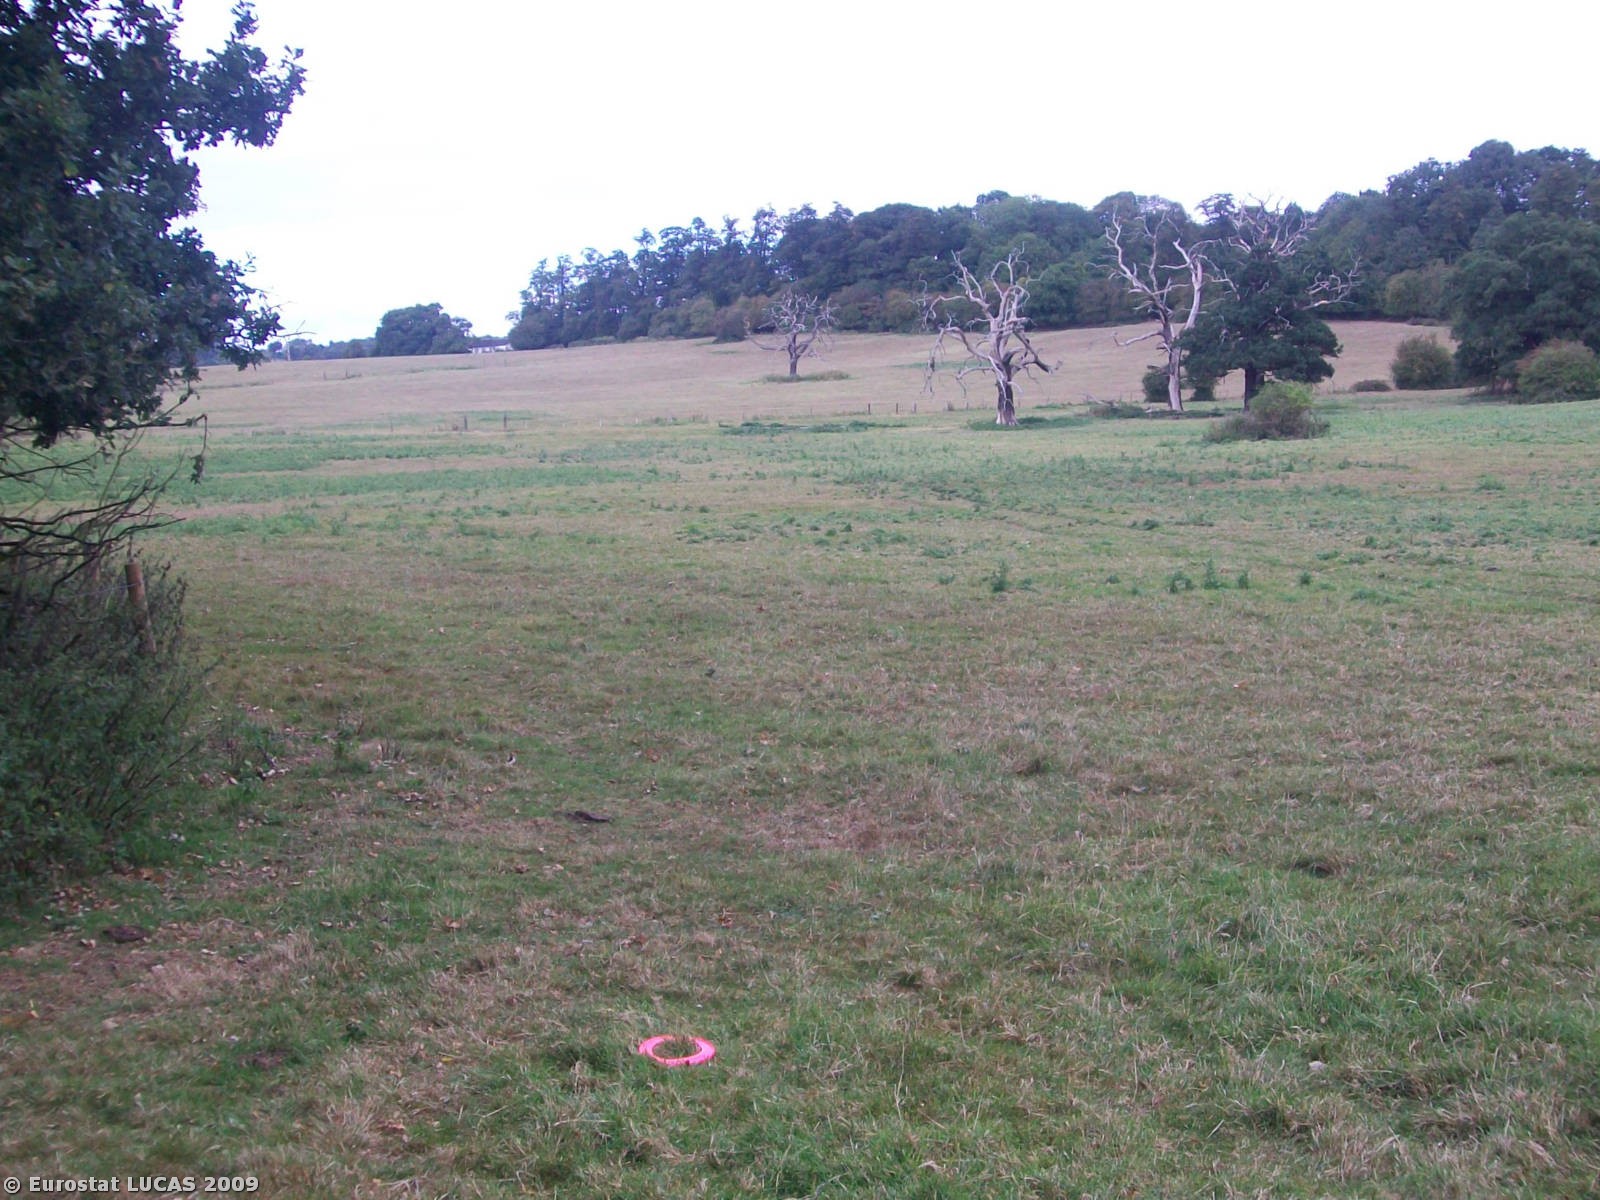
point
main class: Grassland
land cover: Grassland without tree/shrub cover
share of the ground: > 75 %
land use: Agriculture (excluding fallow land and kitchen gardens)
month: September
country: GB
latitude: 51.6770
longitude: 0.1492
